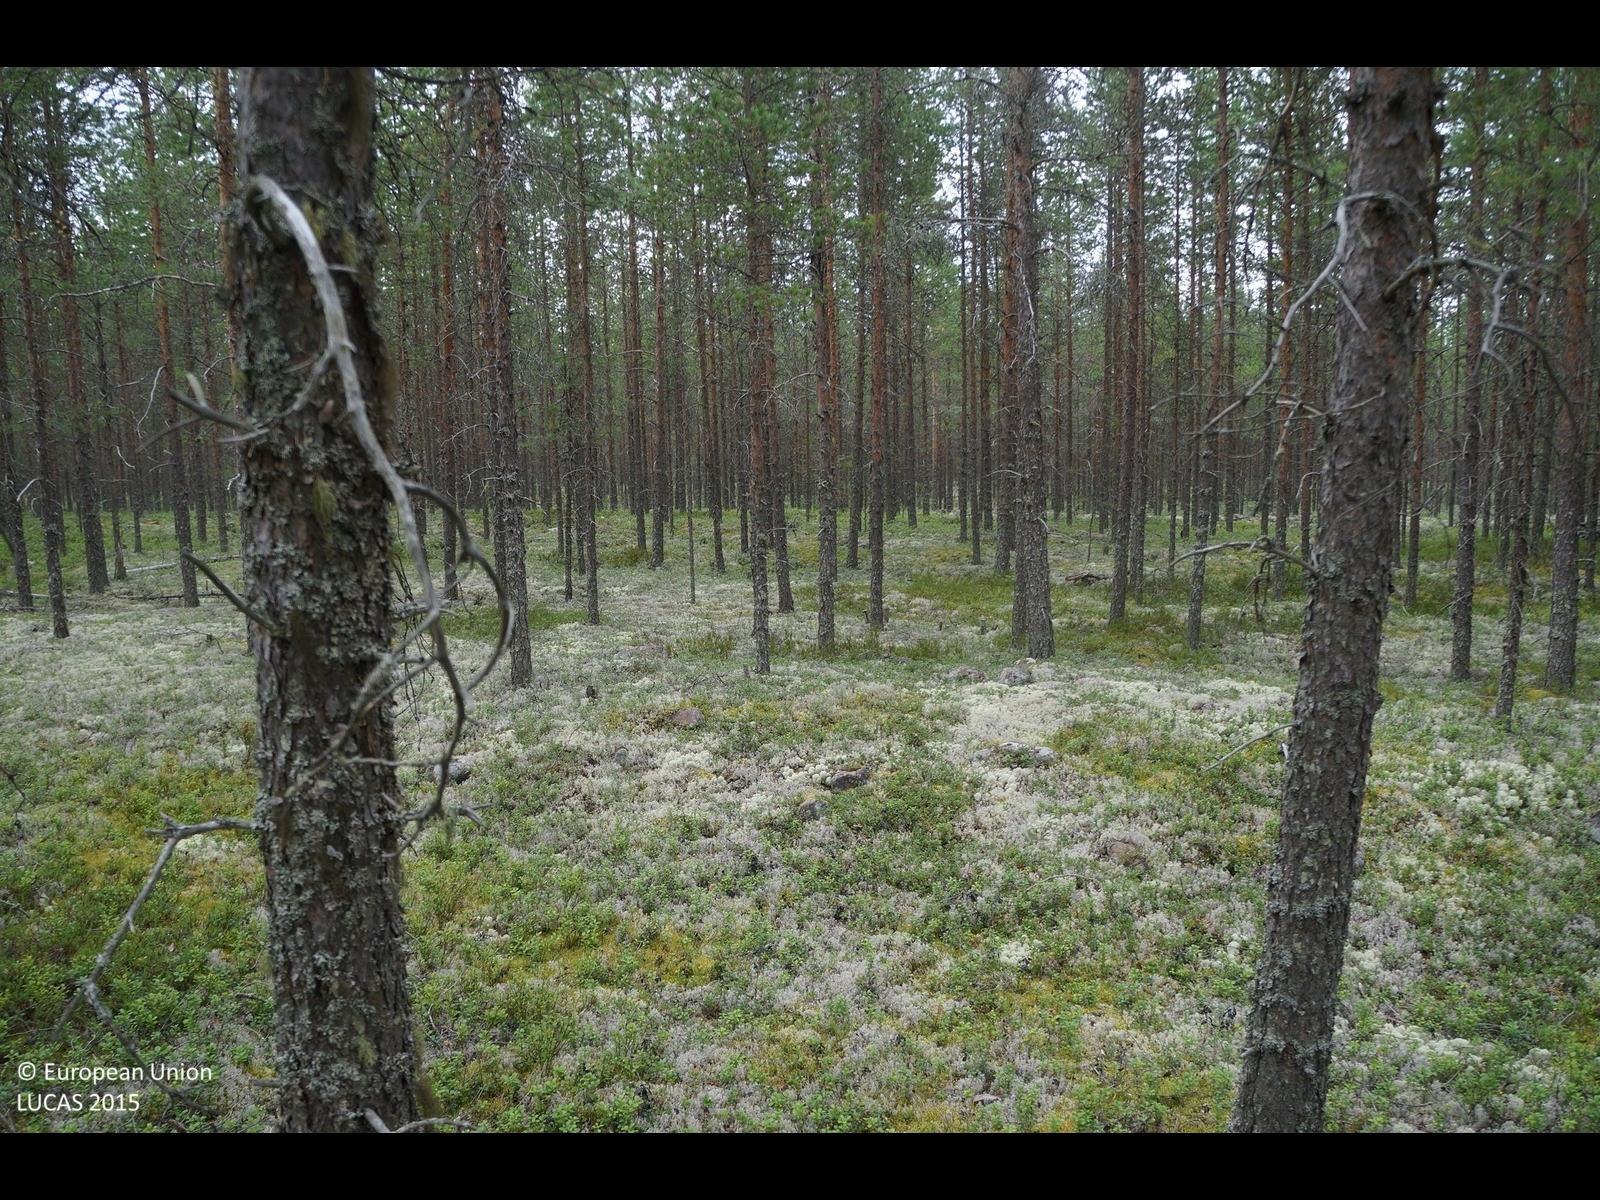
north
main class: Woodland
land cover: Pine dominated coniferous woodland
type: boreal forest
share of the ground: 50 - 75 %
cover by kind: coniferous forest trees 50 %, lichens and mosses 35 %, shrubs 15 %
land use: Forestry
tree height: > 5 m
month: August
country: FI
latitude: 64.8131
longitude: 24.9209
